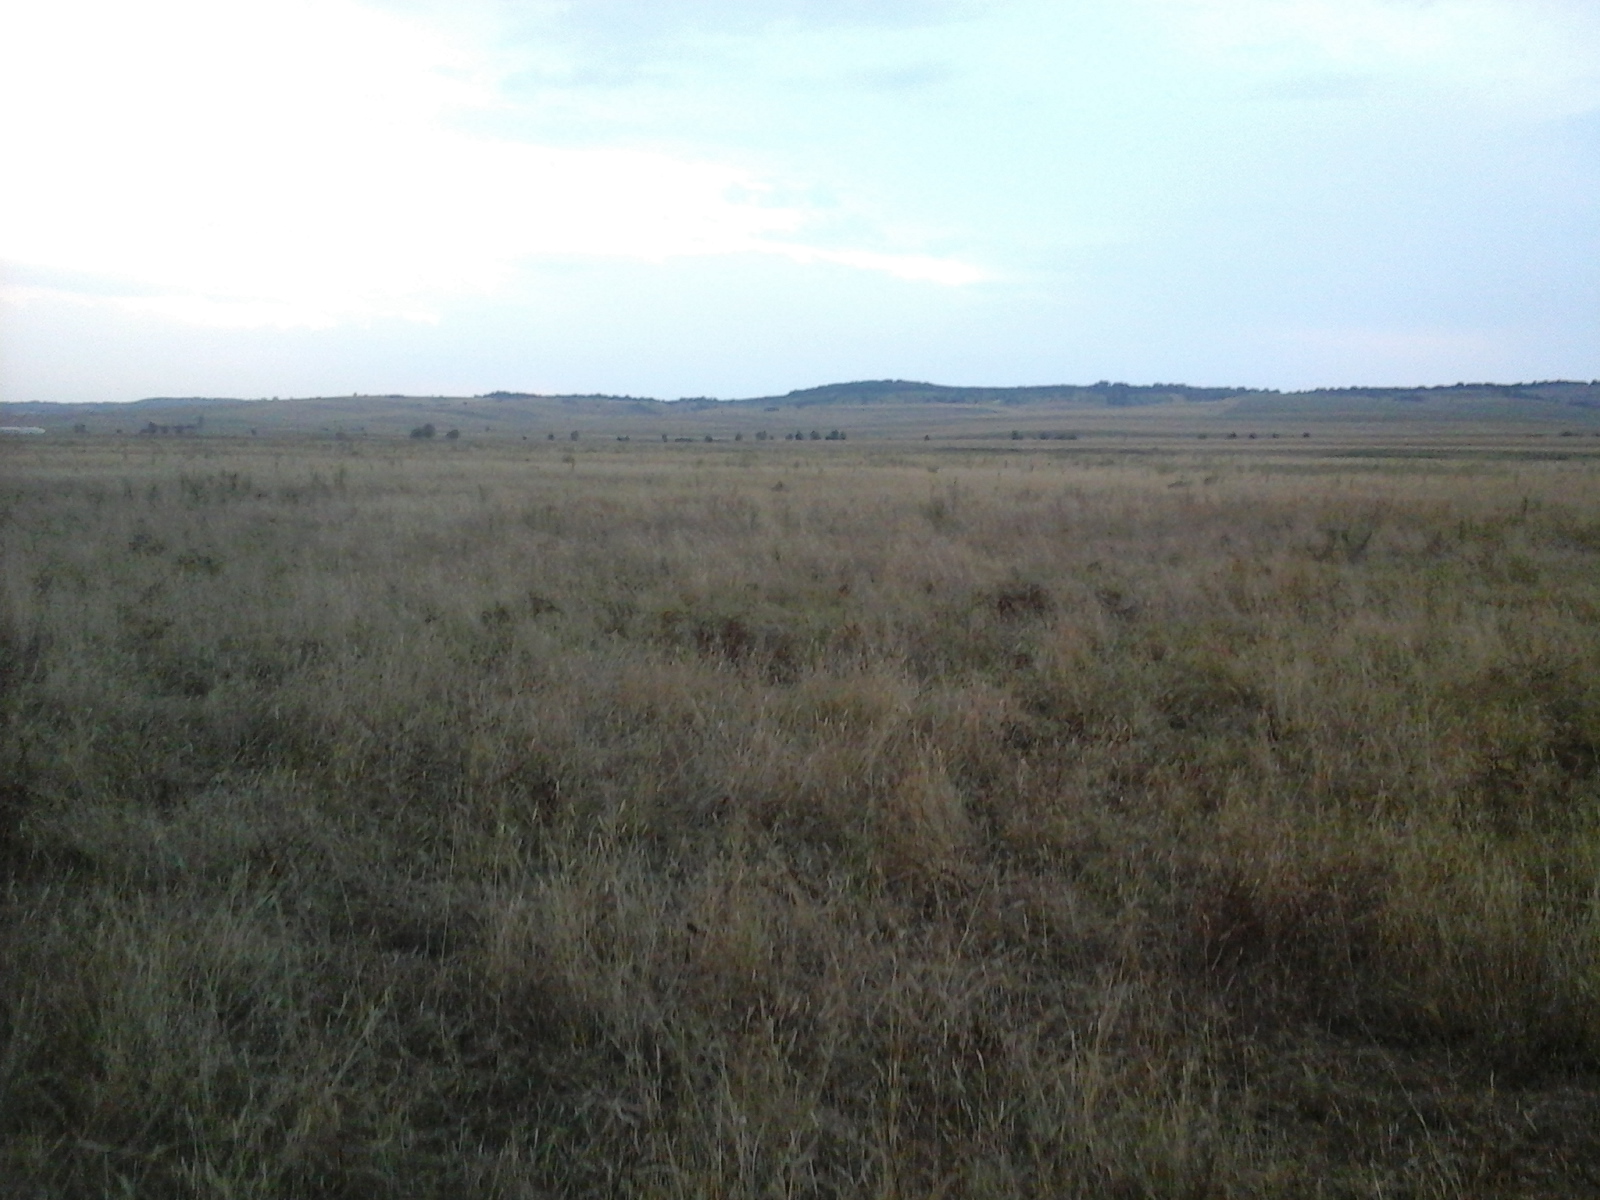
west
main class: Grassland
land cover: Grassland without tree/shrub cover
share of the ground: > 75 %
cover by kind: herbaceous plants 100 %
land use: Agriculture (excluding fallow land and kitchen gardens)
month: August
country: RO
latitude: 44.4809
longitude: 22.8294
